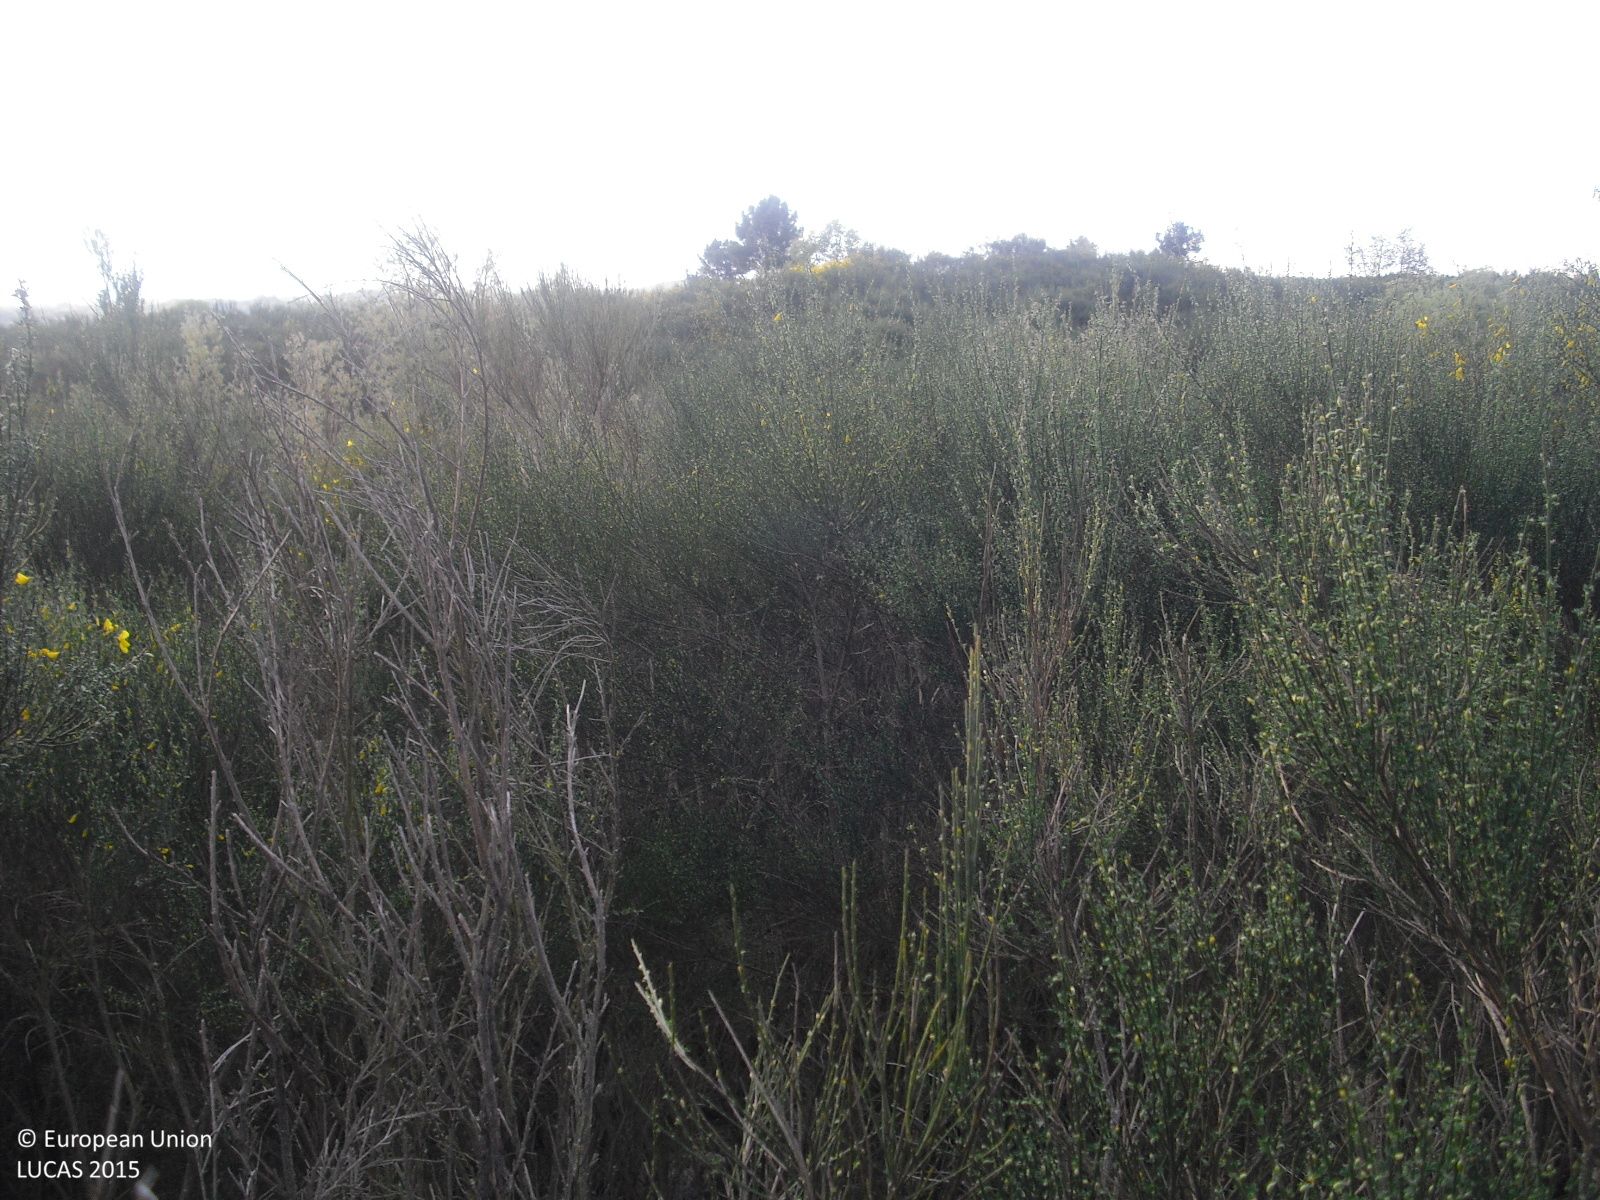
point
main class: Shrubland
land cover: Shrubland with sparse tree cover
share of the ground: 50 - 75 %
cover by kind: shrubs 75 %, consolidated bare surface 20 %, coniferous forest trees 5 %
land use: Semi-natural and natural areas not in use
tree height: < 5 m
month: April
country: ES
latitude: 41.9082
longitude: -7.5056
